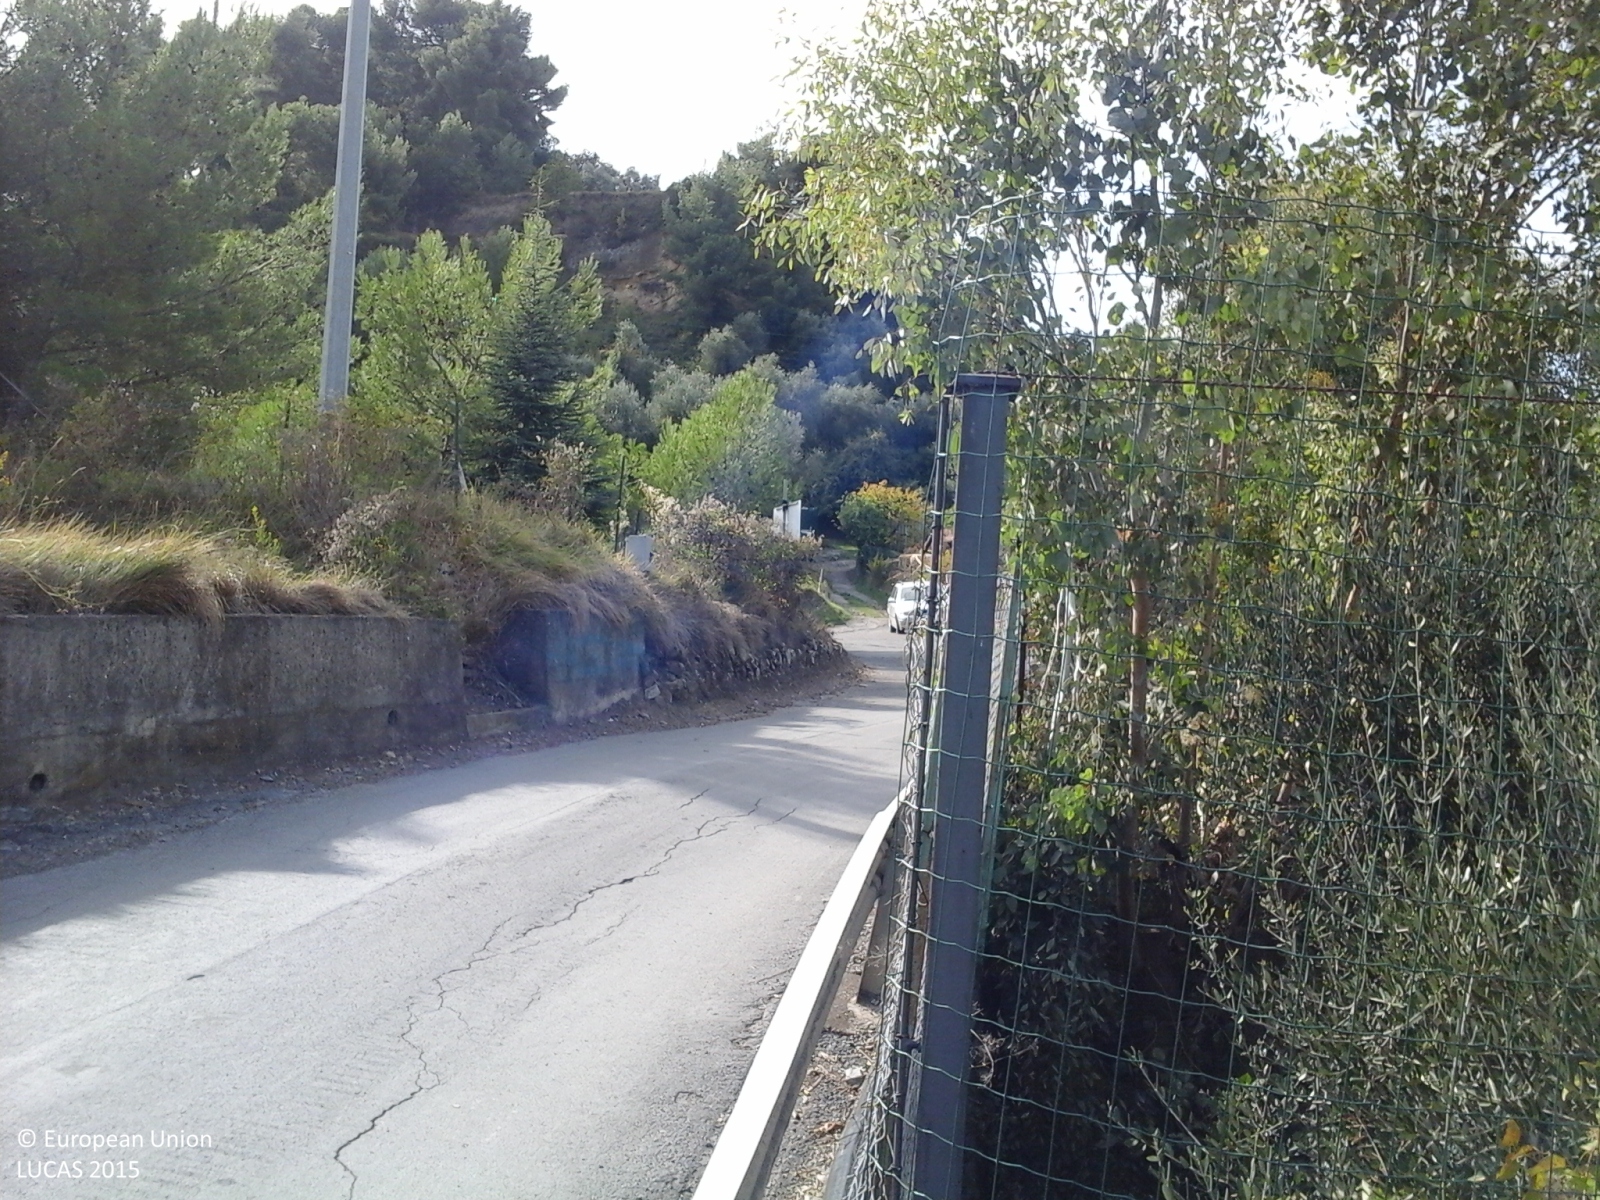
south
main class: Woodland
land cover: Broadleaved woodland
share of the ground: > 75 %
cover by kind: broadleaved forest trees 100 %
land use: Semi-natural and natural areas not in use
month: October
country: IT
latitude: 43.8406
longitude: 7.8288
